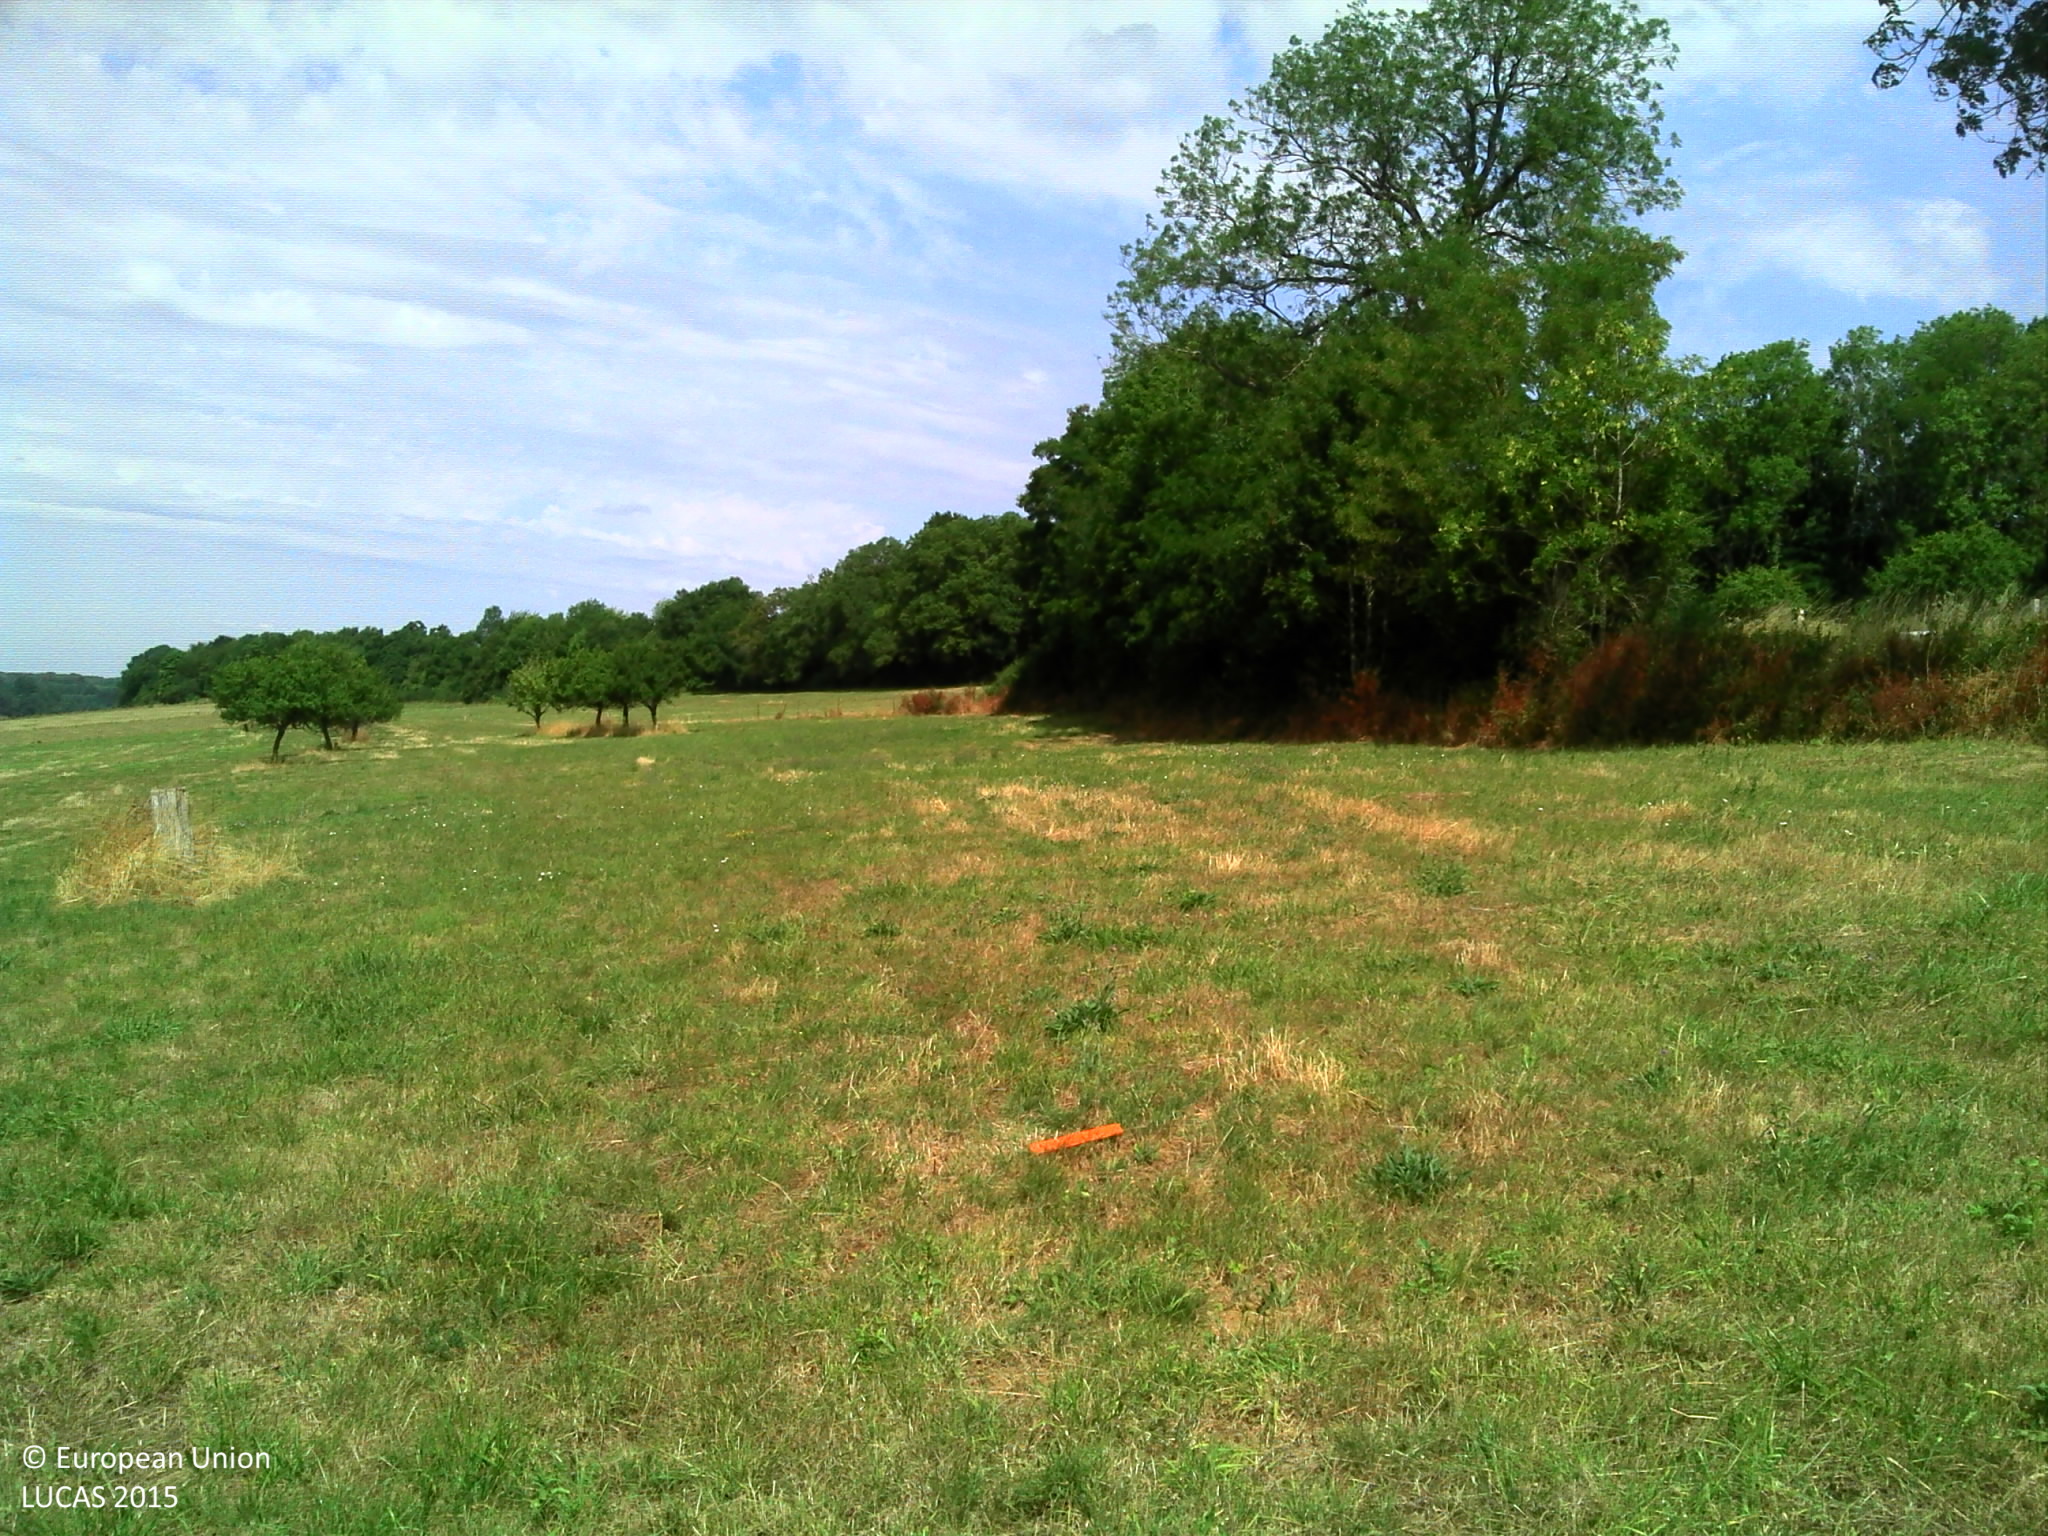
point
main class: Grassland
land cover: Grassland with sparse tree/shrub cover
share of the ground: > 75 %
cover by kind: herbaceous plants 95 %, broadleaved forest trees 5 %
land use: Agriculture (excluding fallow land and kitchen gardens)
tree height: > 5 m
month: July
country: FR
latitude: 48.4018
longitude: 5.9613
